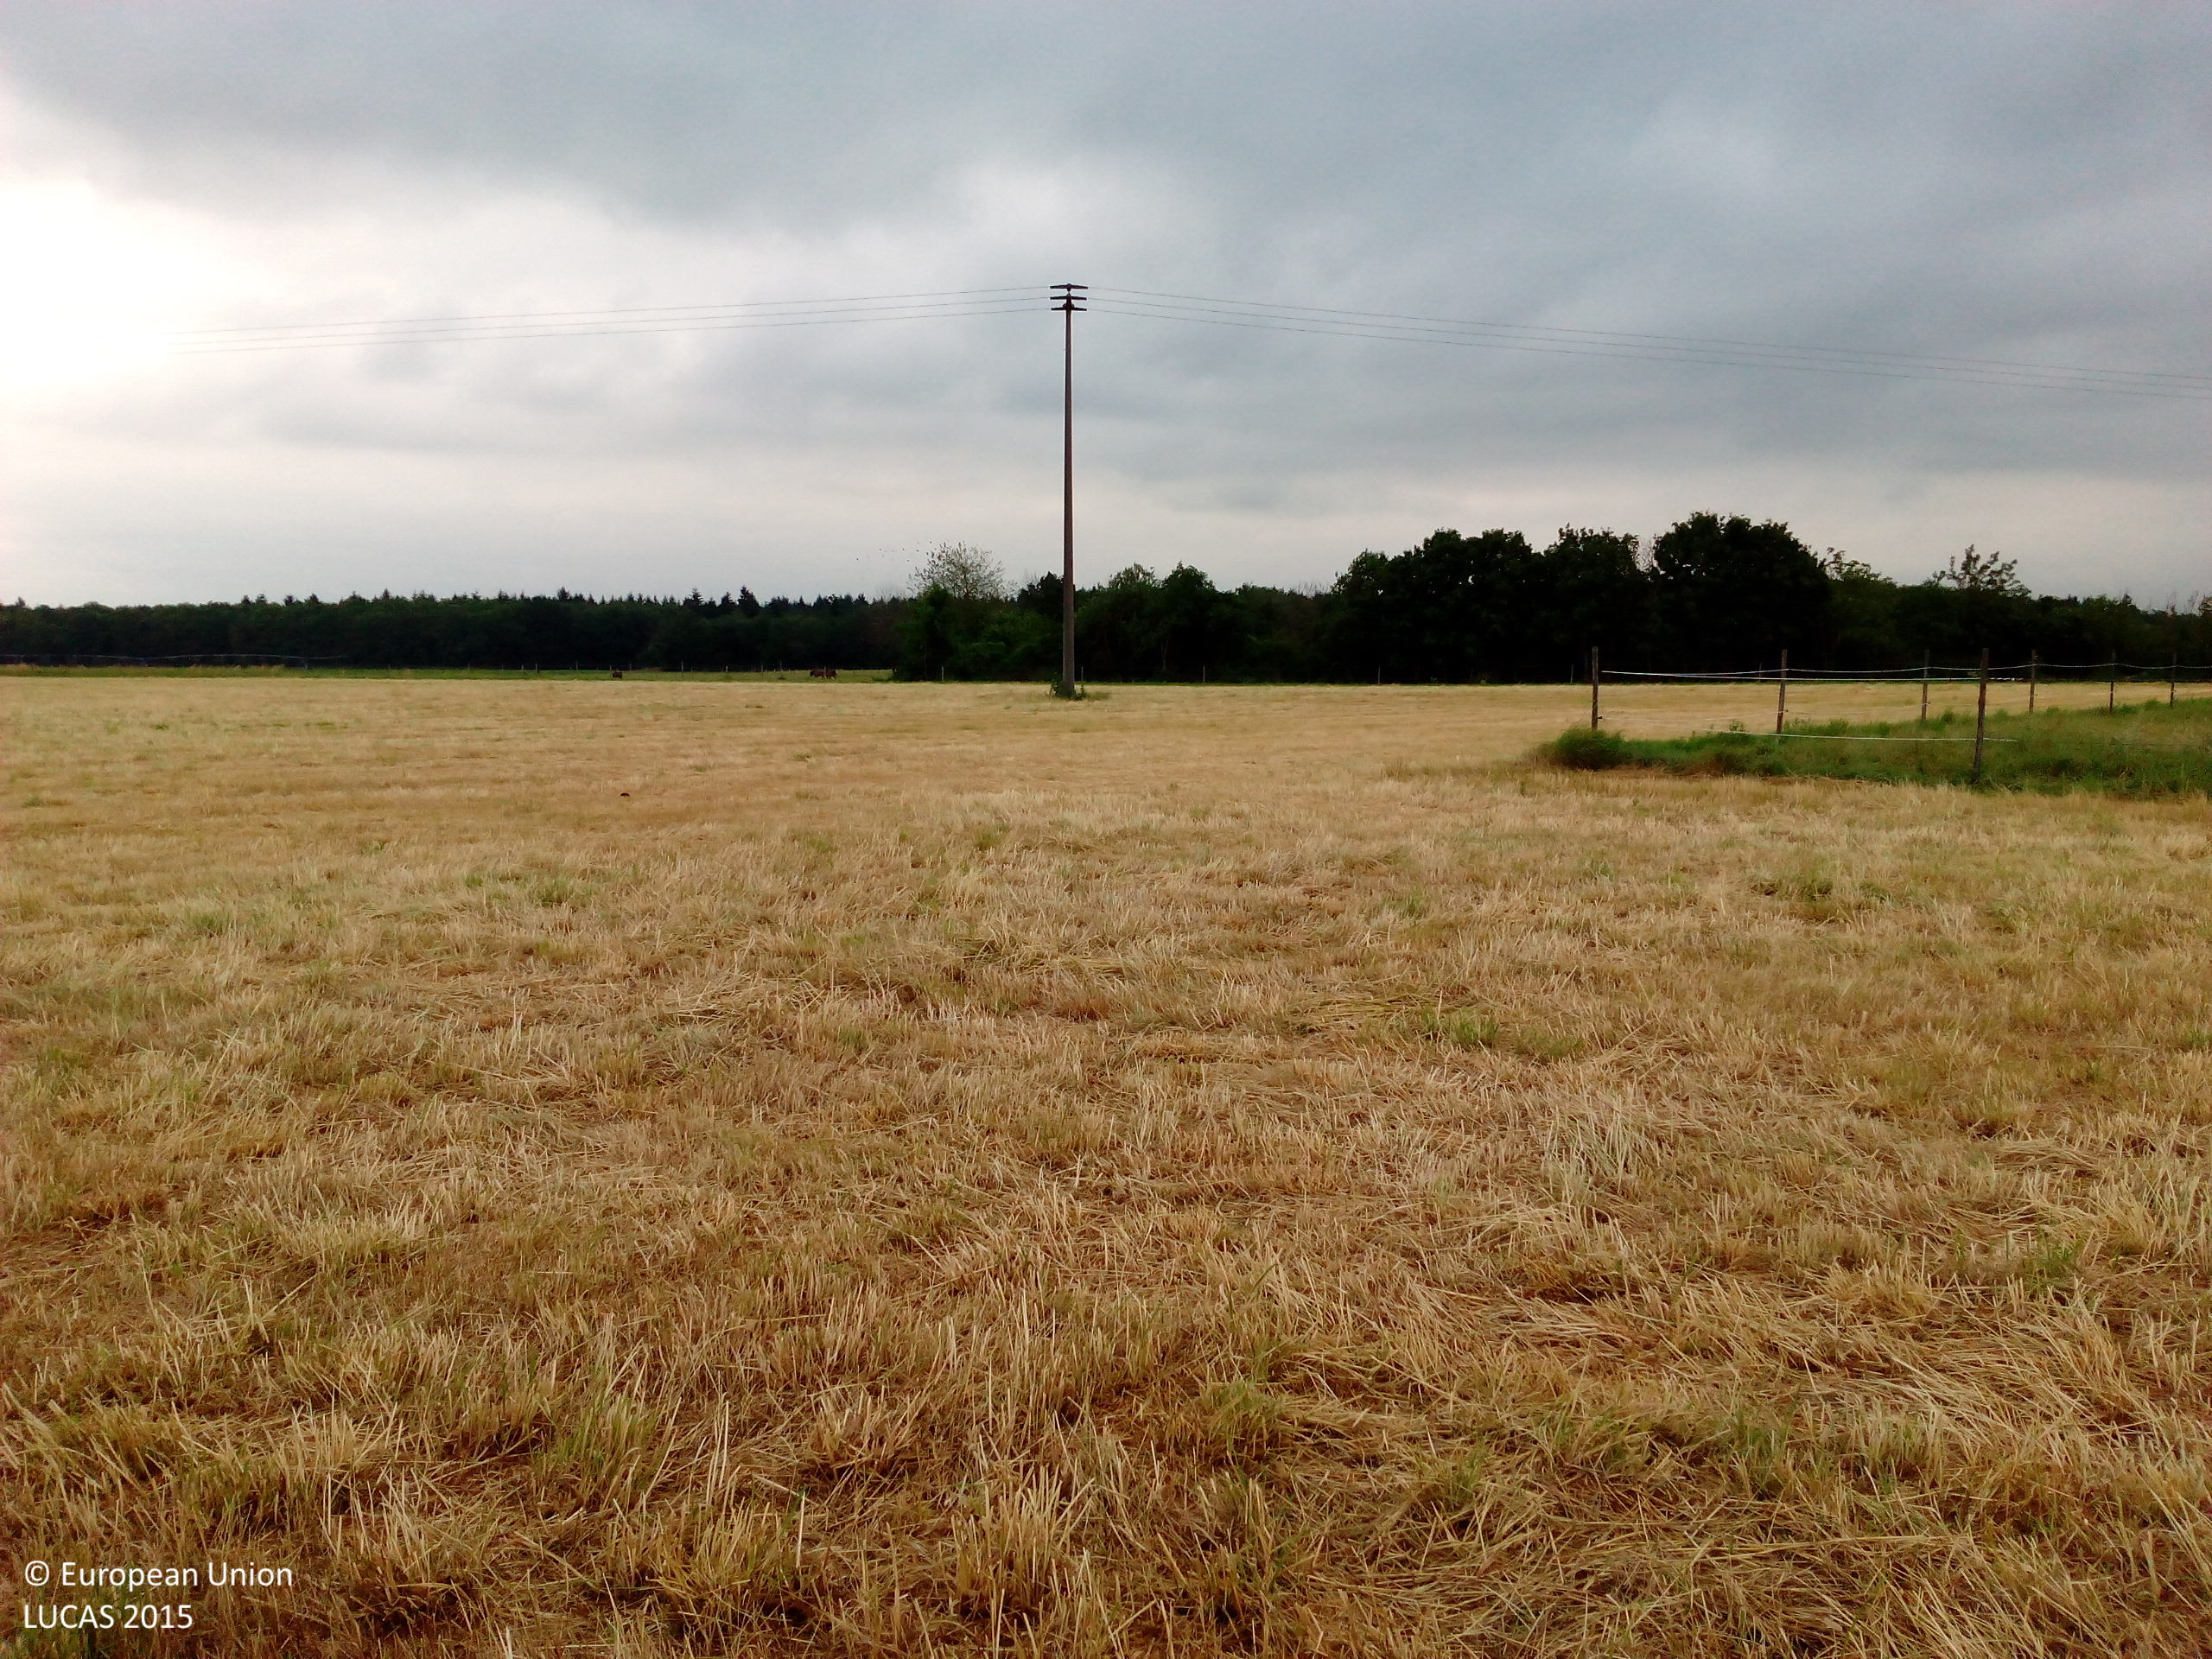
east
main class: Grassland
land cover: Grassland without tree/shrub cover
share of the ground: > 75 %
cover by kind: herbaceous plants 100 %
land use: Agriculture (excluding fallow land and kitchen gardens)
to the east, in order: Grassland without tree/shrub cover; Electric lines; Grassland without tree/shrub cover; Fences; Tracks; Broadleaved woodland; Grassland without tree/shrub cover; Tracks; Grassland without tree/shrub cover; Fences; Grassland without tree/shrub cover
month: June
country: DE
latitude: 48.0000
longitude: 7.6289
